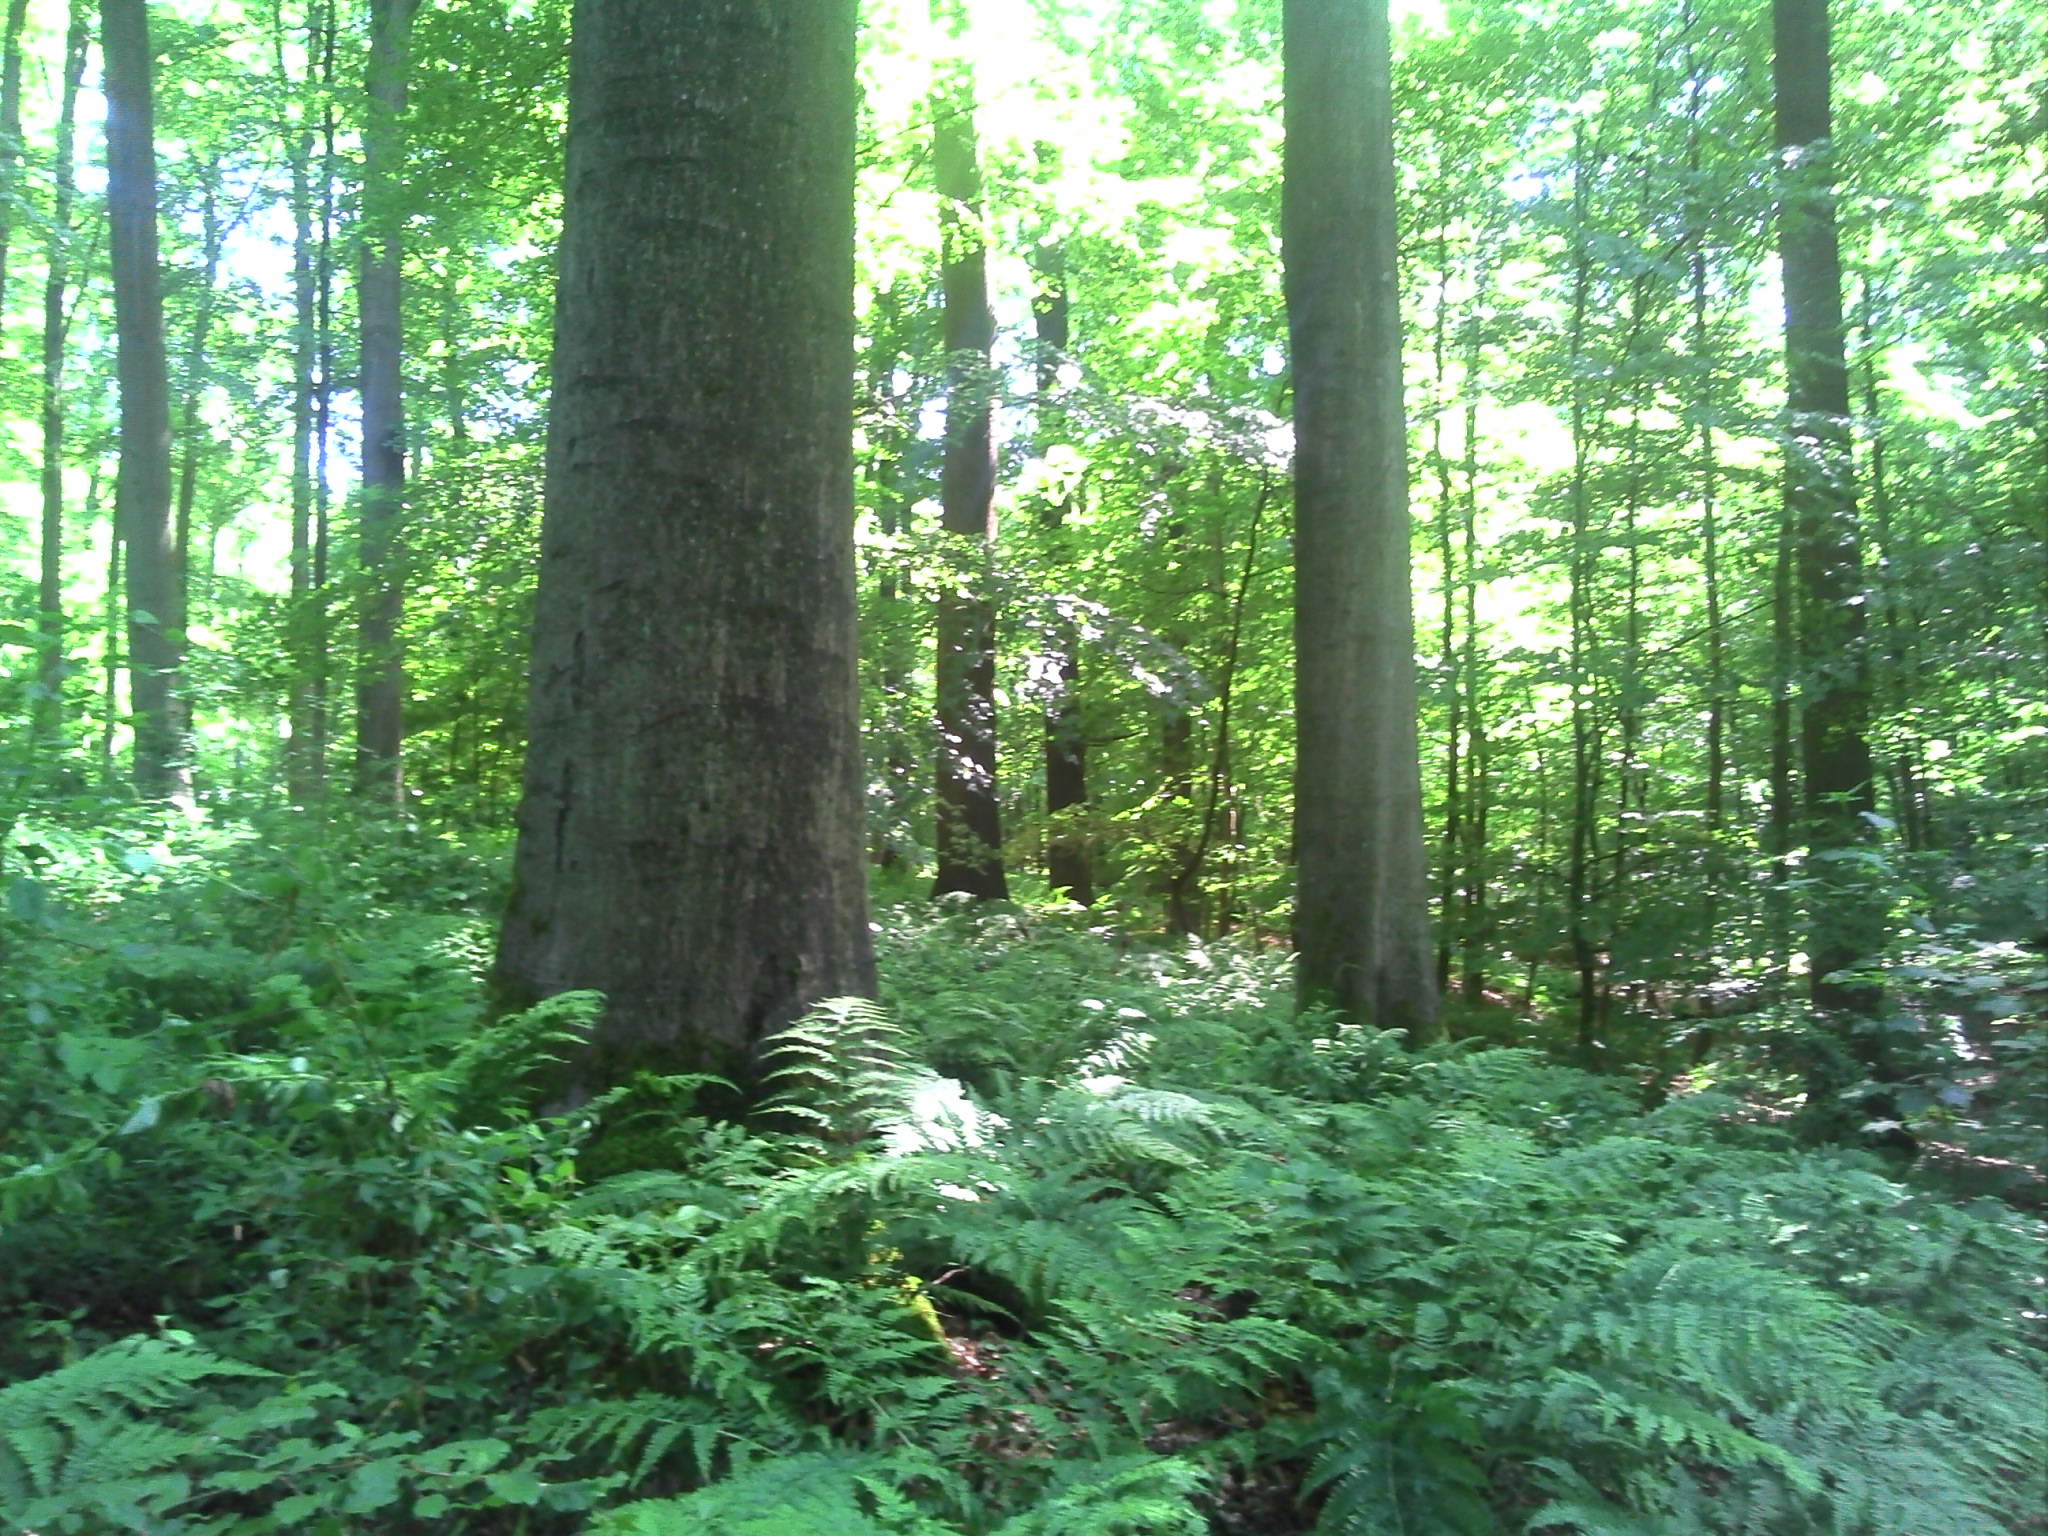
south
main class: Woodland
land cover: Broadleaved woodland
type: beech forest
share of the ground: > 75 %
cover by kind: broadleaved forest trees 90 %, herbaceous plants 10 %
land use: Forestry
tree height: > 5 m
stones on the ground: < 10 %
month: June
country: BE
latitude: 50.7522
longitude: 4.4536
